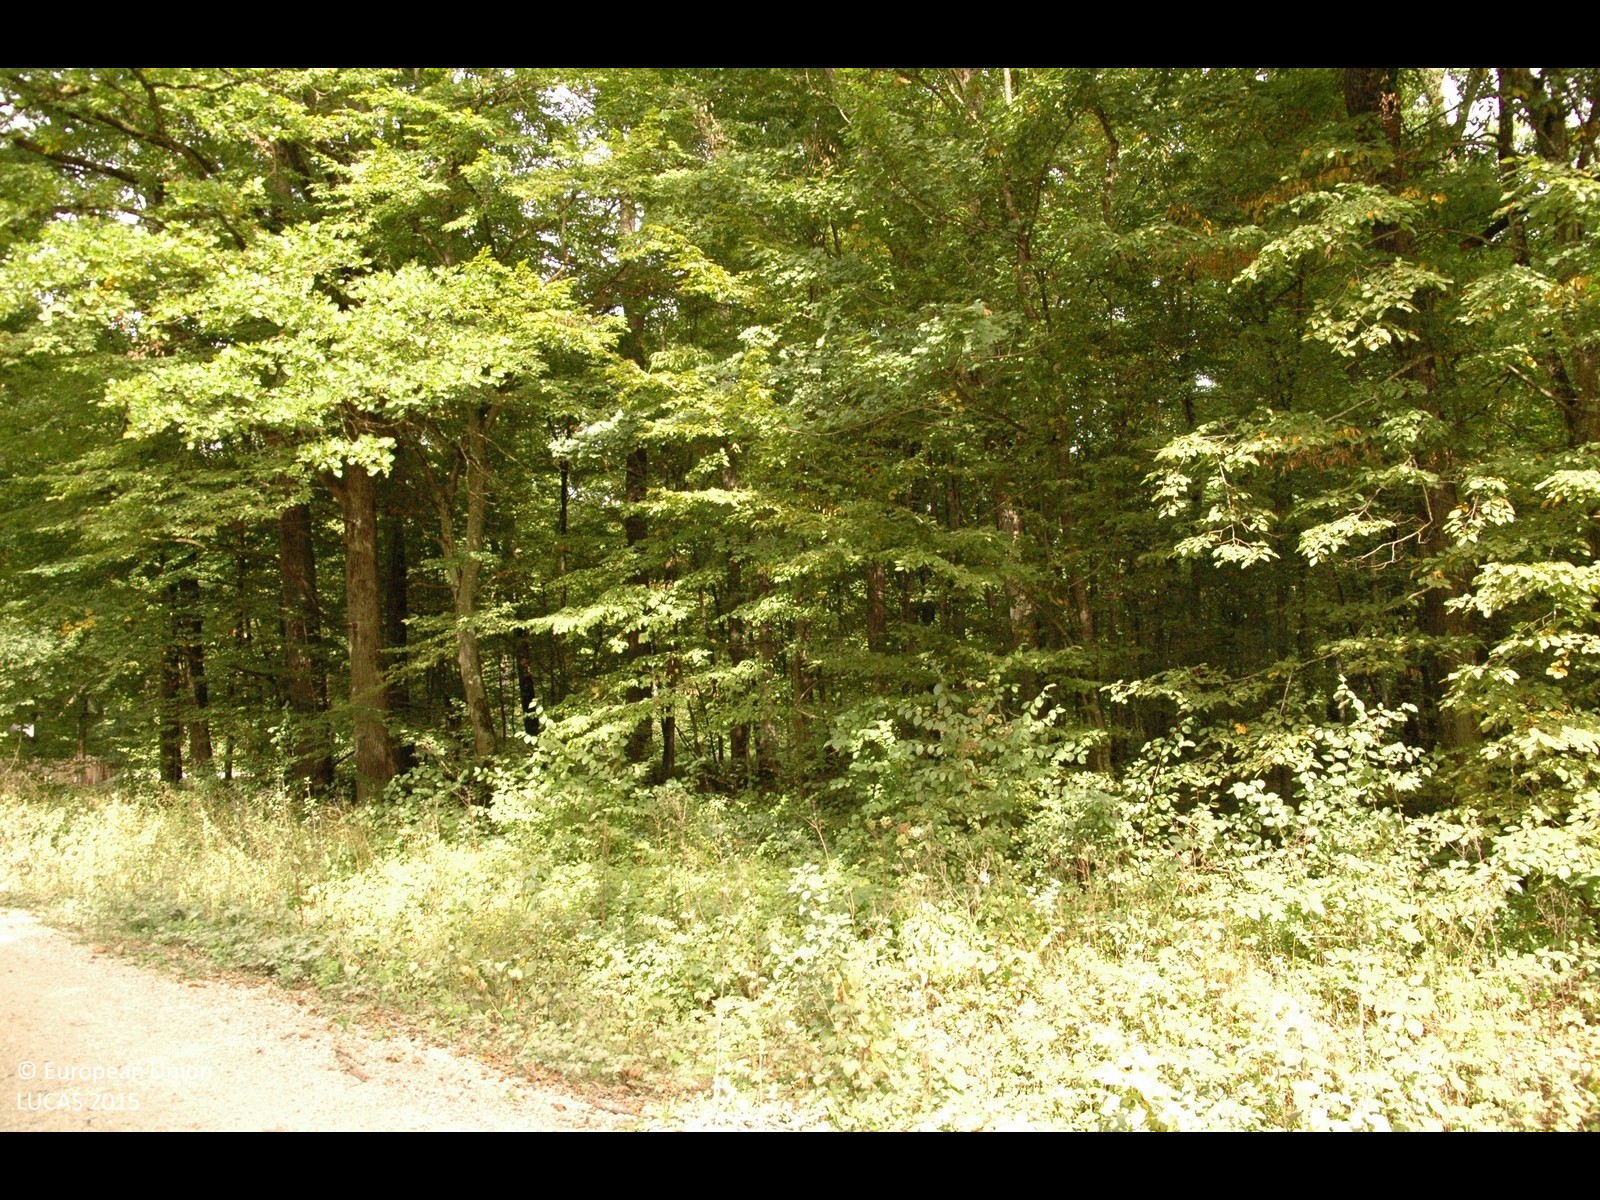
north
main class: Woodland
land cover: Broadleaved woodland
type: mesophytic deciduous forest
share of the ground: > 75 %
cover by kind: broadleaved forest trees 100 %
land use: Forestry
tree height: > 5 m
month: September
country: HR
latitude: 45.6282
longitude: 16.2189
